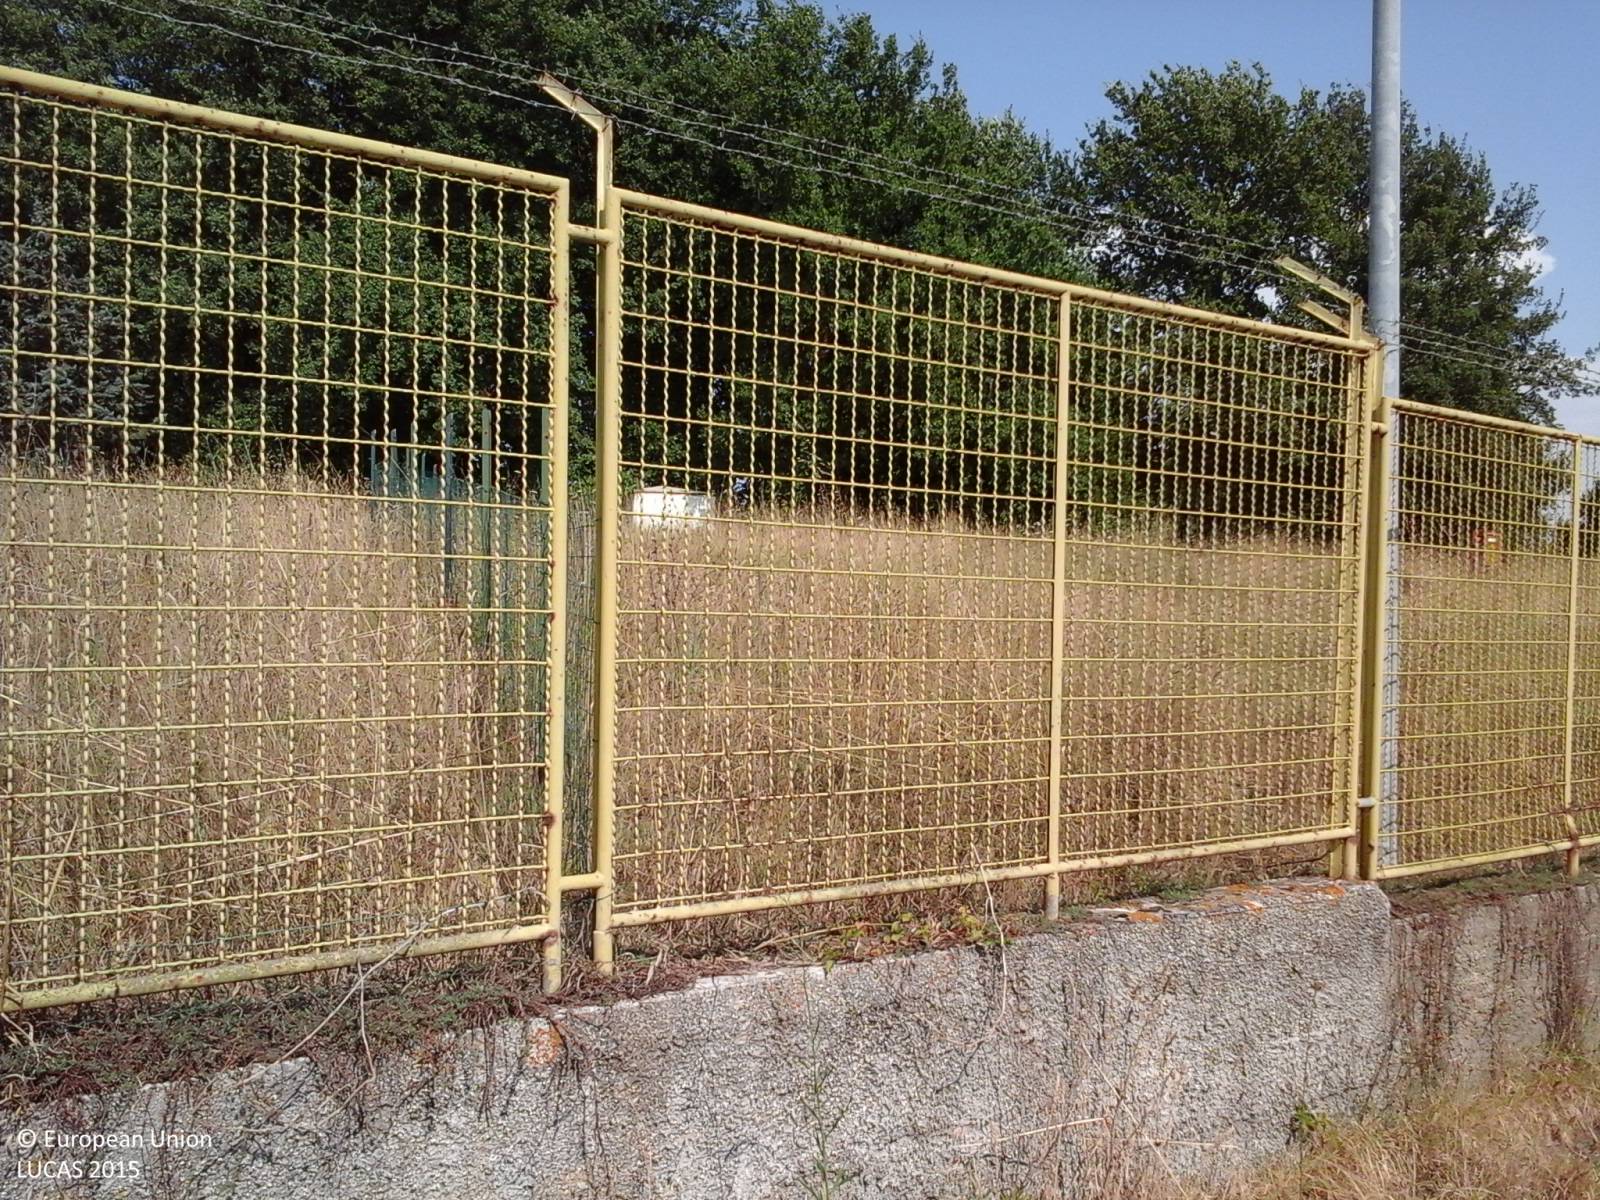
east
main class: Grassland
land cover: Grassland without tree/shrub cover
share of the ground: > 75 %
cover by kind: herbaceous plants 100 %
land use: Manufacturing of food, beverages and tobacco products
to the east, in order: Grassland without tree/shrub cover; Broadleaved woodland; Grassland with sparse tree/shrub cover; Artificial constructions in urban areas
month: July
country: IT
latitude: 42.0677
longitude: 12.3000
